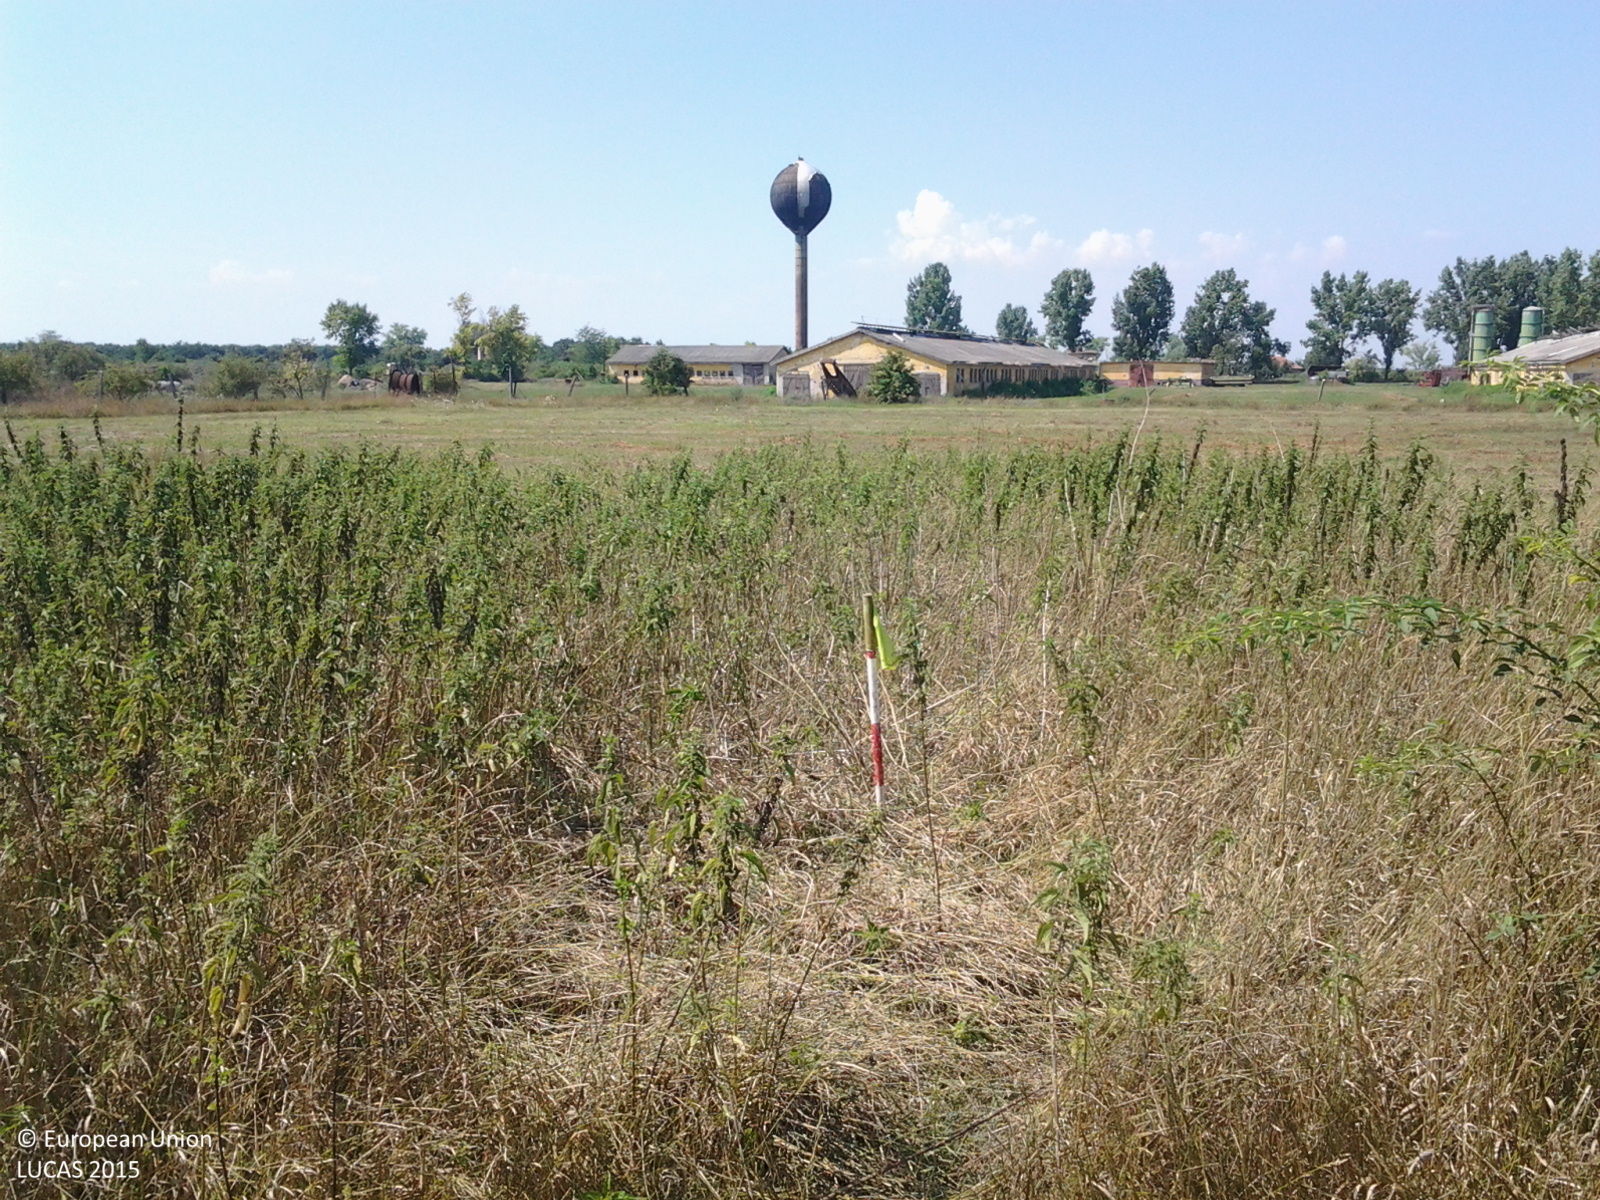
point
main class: Grassland
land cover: Grassland without tree/shrub cover
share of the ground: > 75 %
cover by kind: herbaceous plants 100 %
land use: Agriculture (excluding fallow land and kitchen gardens)
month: August
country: HU
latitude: 47.2077
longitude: 19.7792
